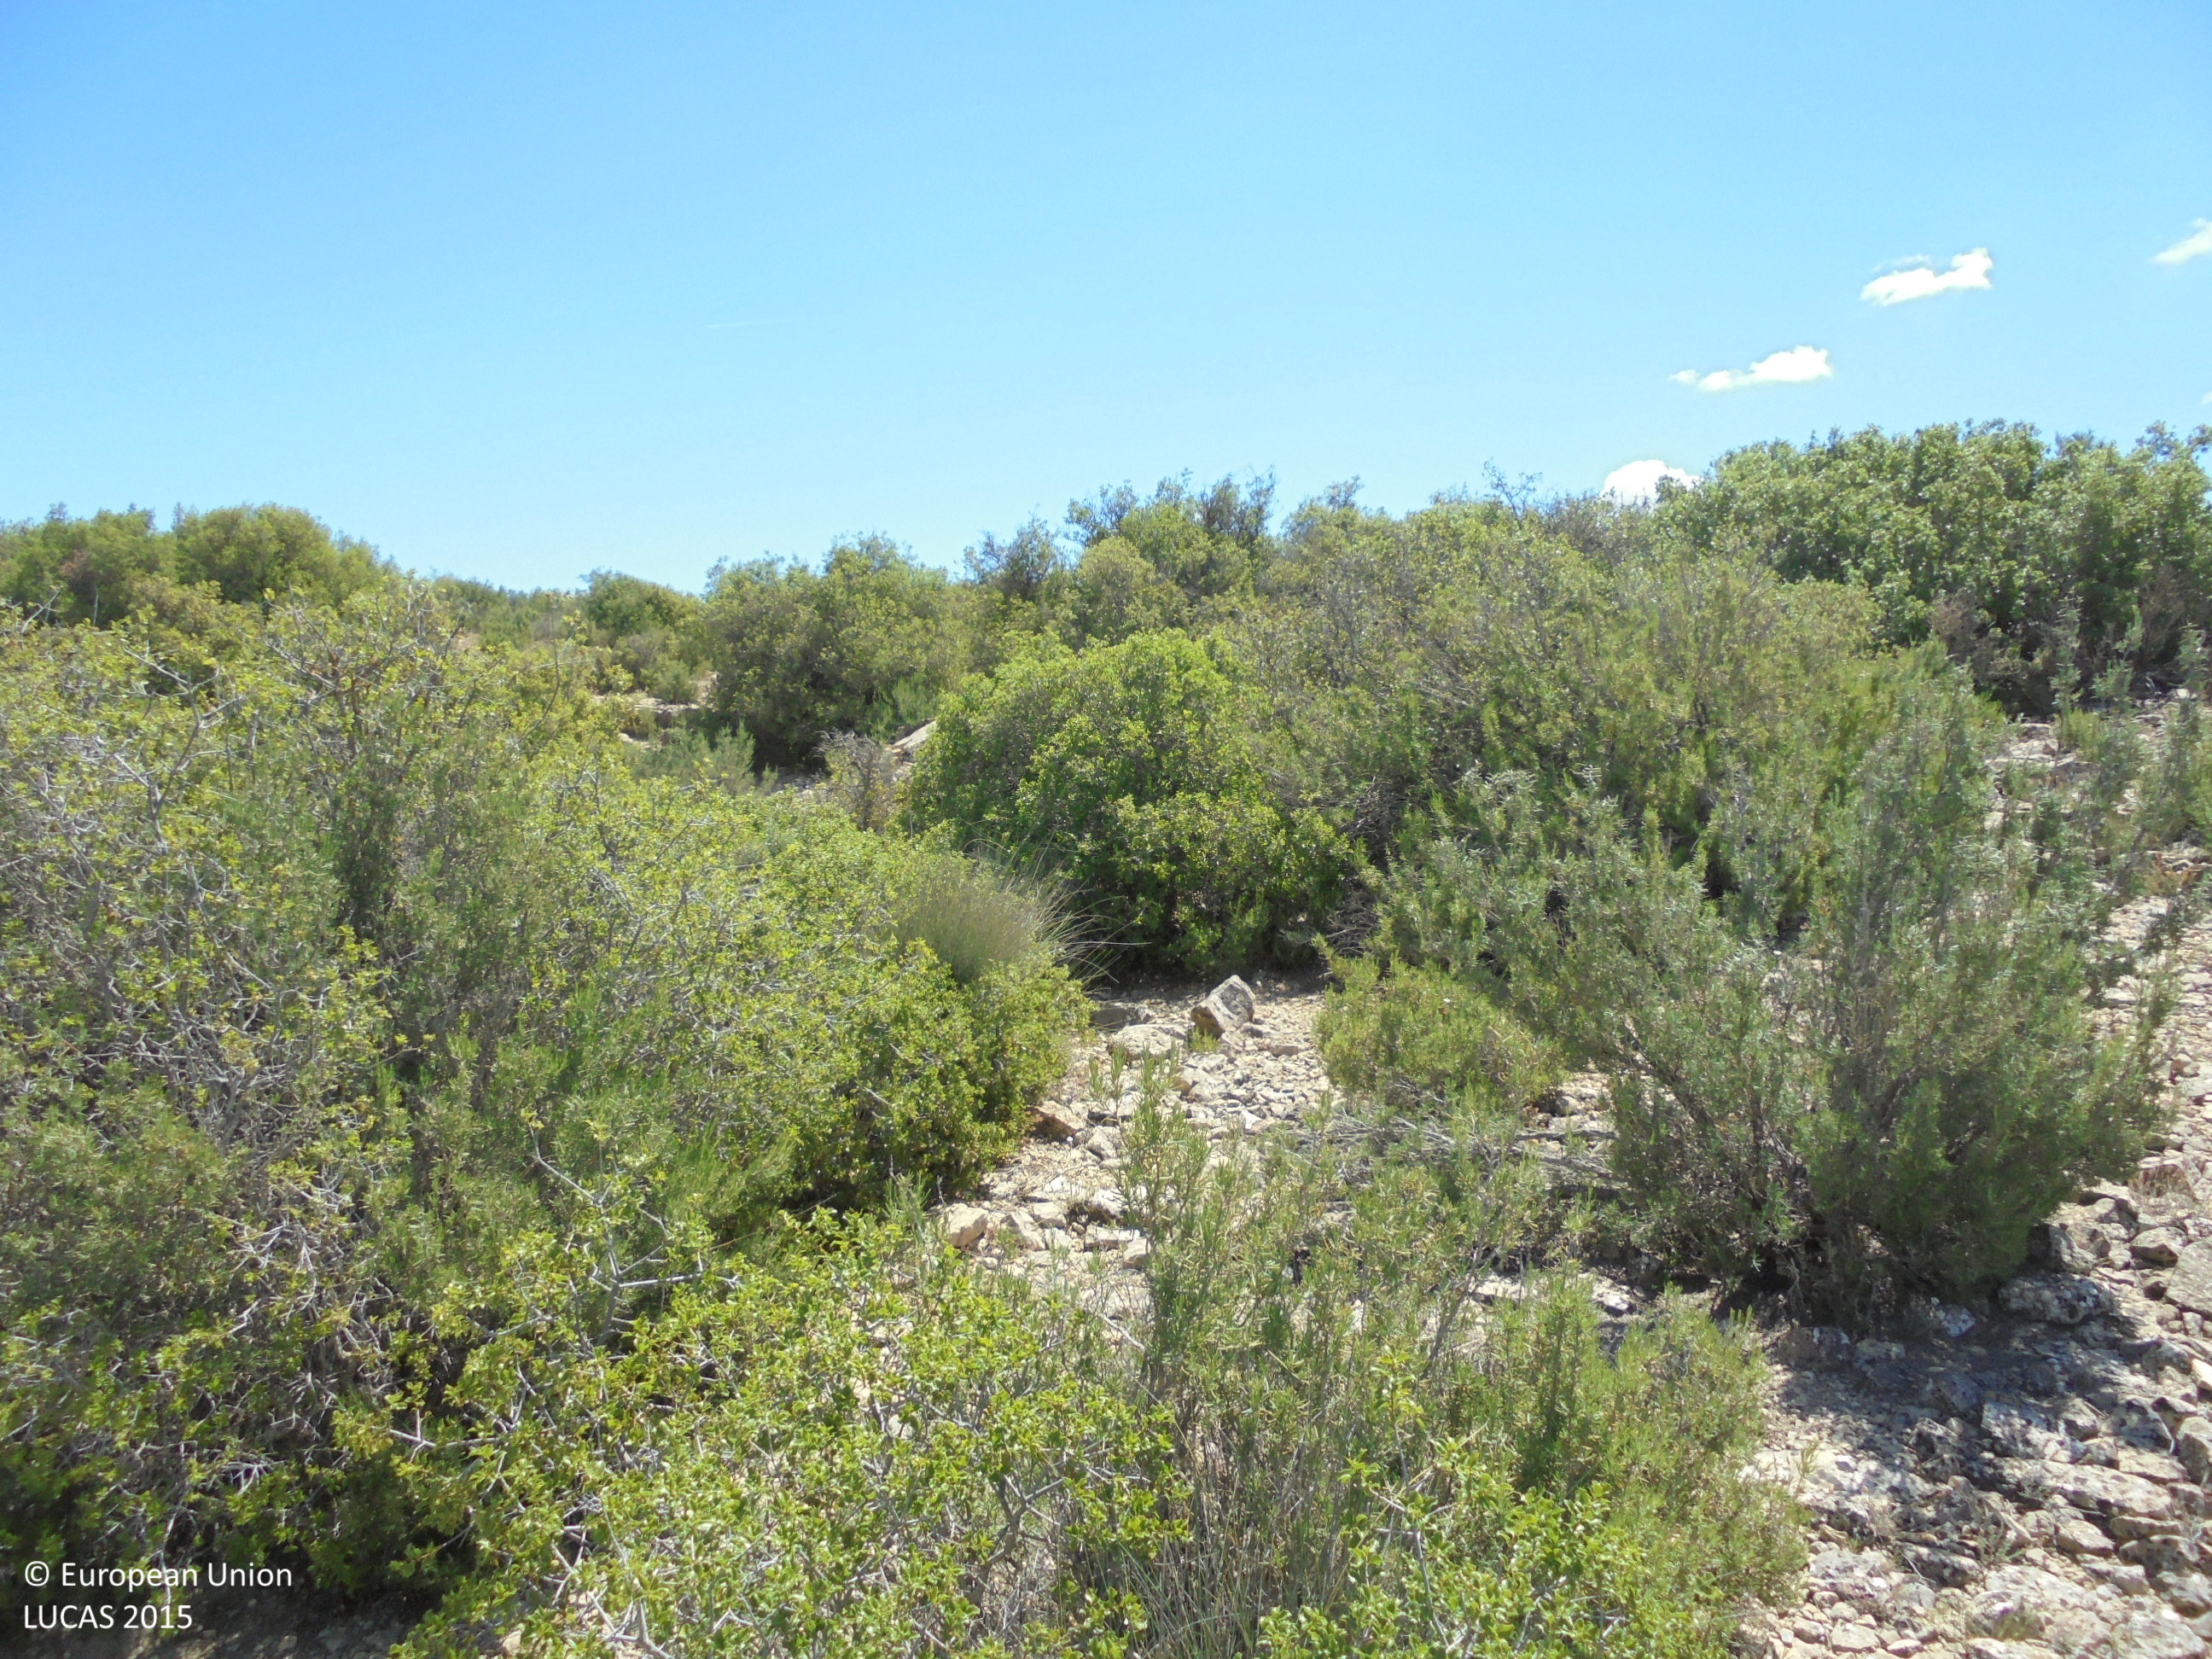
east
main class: Shrubland
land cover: Shrubland without tree cover
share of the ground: 50 - 75 %
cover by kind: shrubs 65 %, unconsolidated bare surface 35 %
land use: Semi-natural and natural areas not in use
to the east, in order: Shrubland without tree cover; Broadleaved woodland; Tracks; Electric lines; Shrubland with sparse tree cover
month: May
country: ES
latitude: 38.8942
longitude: -1.6542
